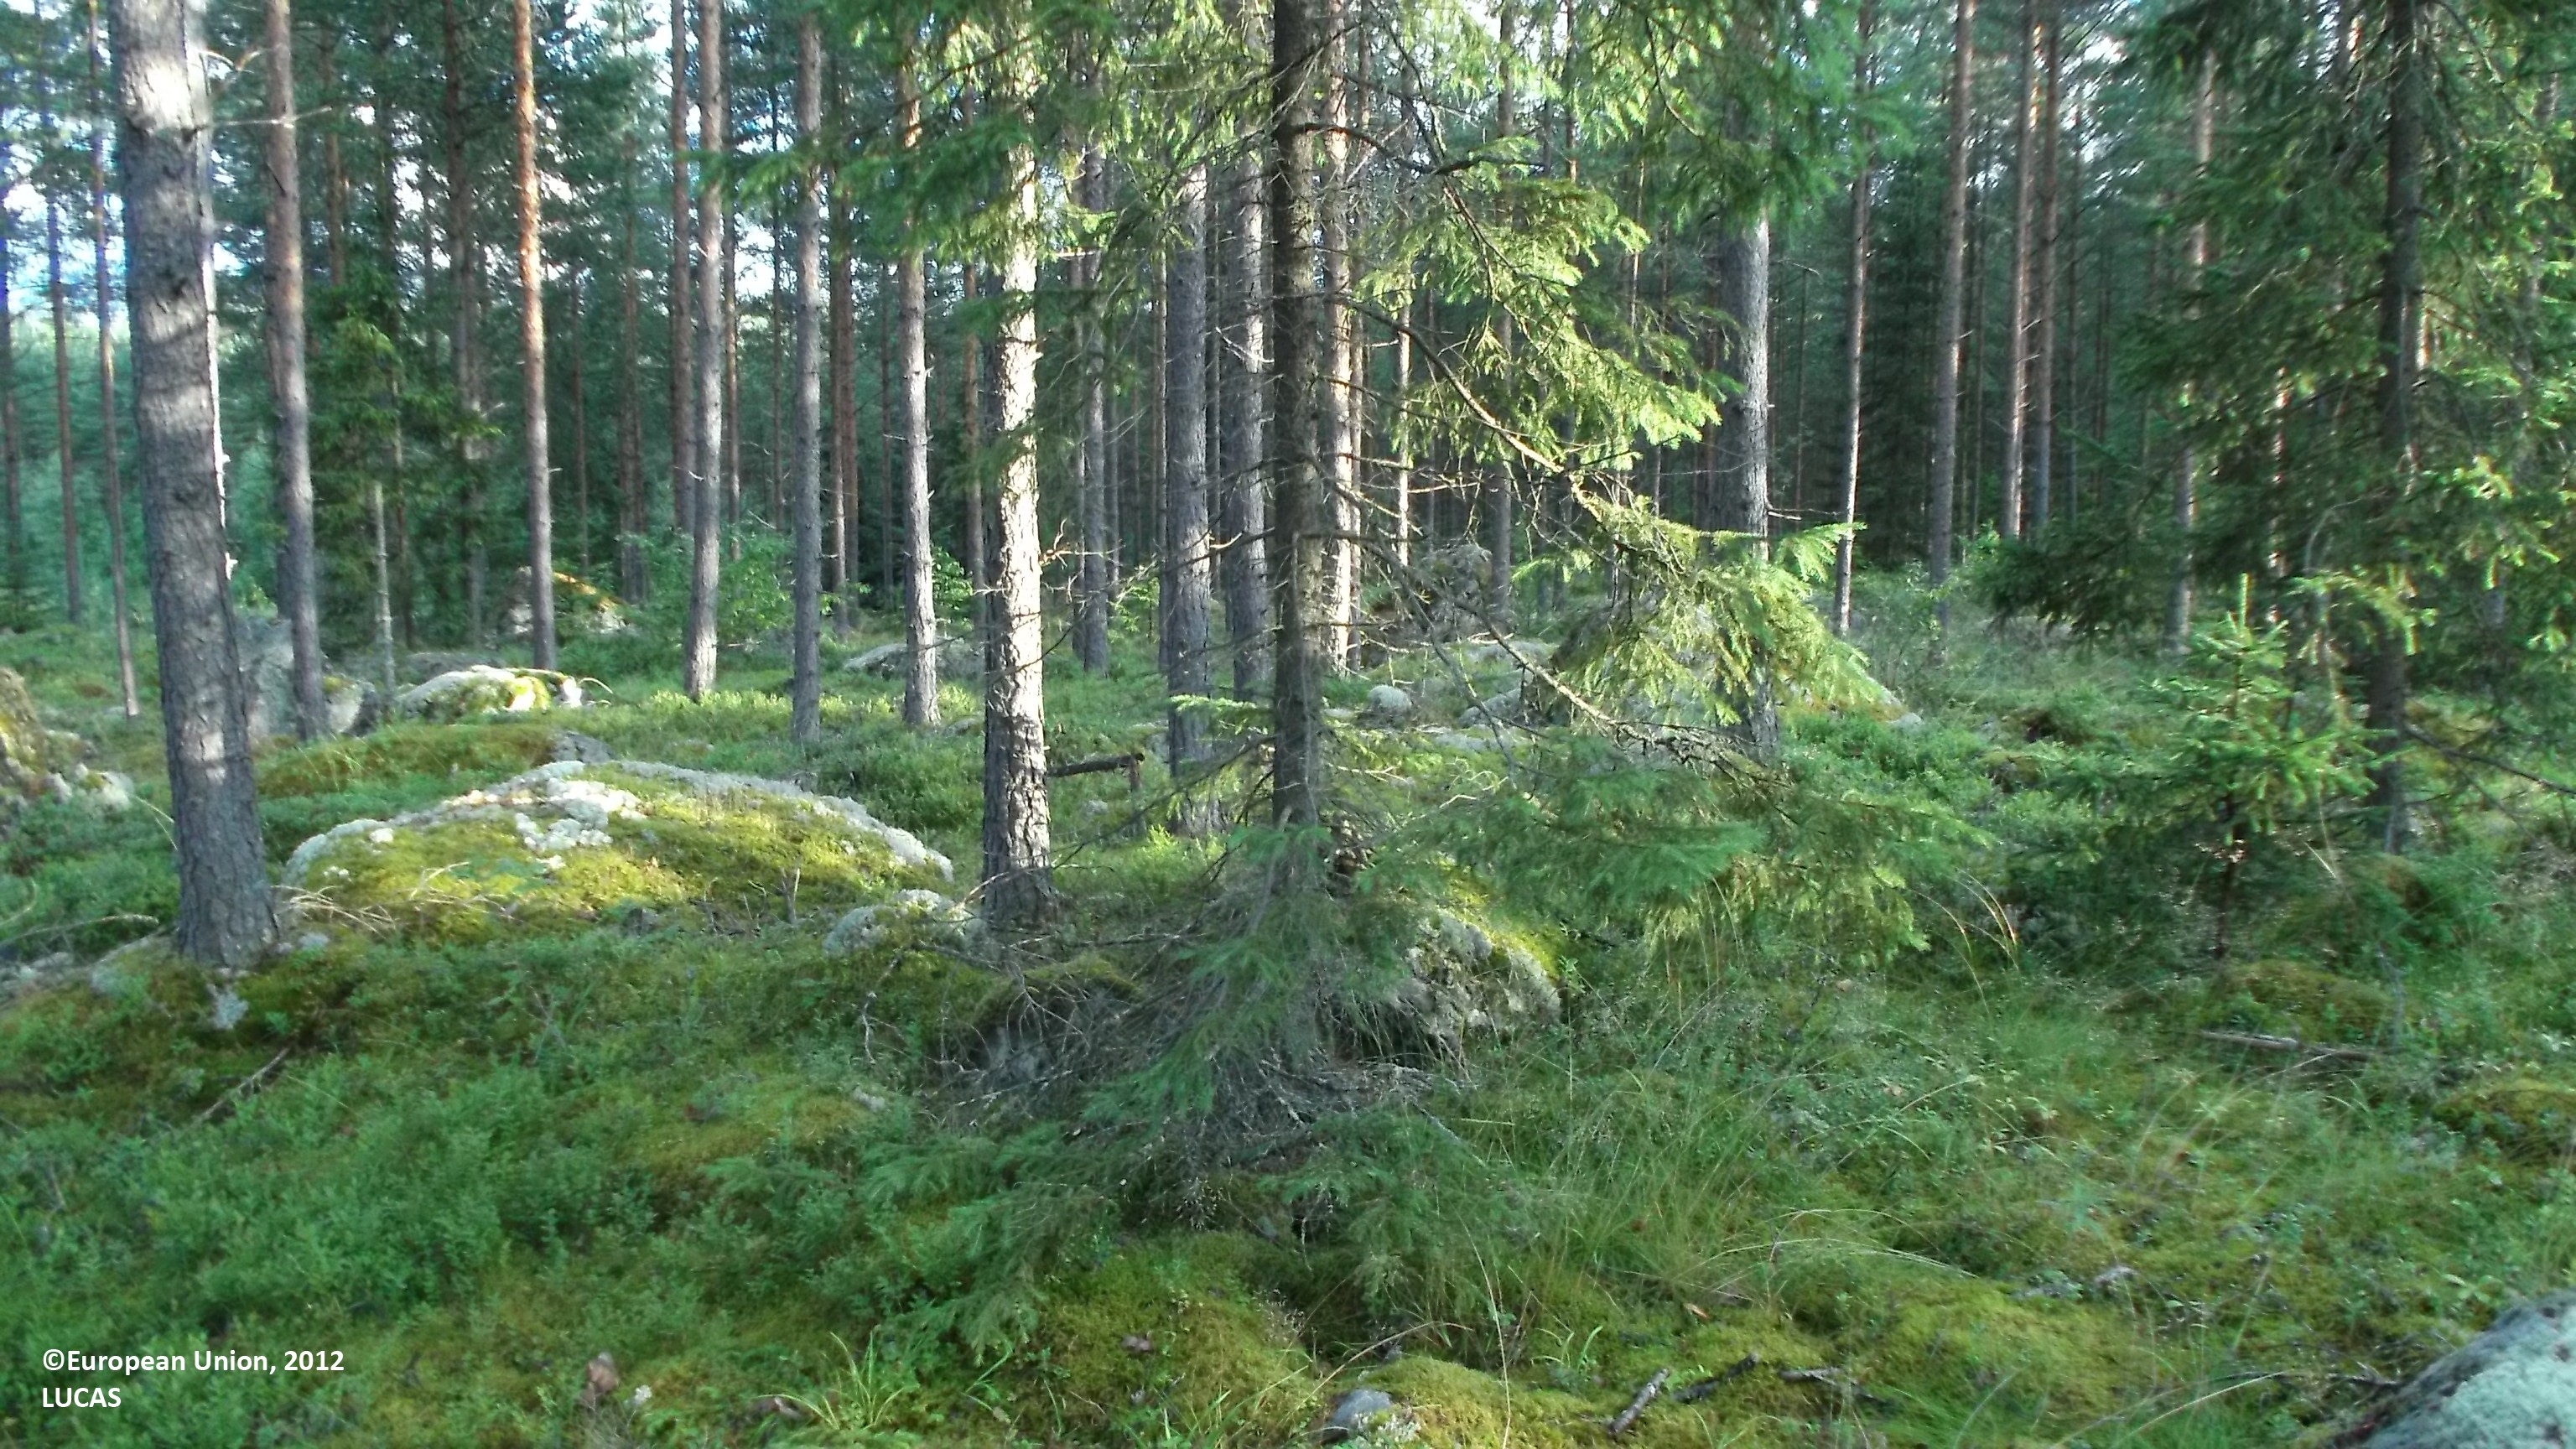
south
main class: Woodland
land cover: Pine dominated coniferous woodland
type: boreal forest
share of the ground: 25 - 50 %
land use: Forestry
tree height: > 5 m
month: August
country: FI
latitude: 63.8717
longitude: 23.3048
